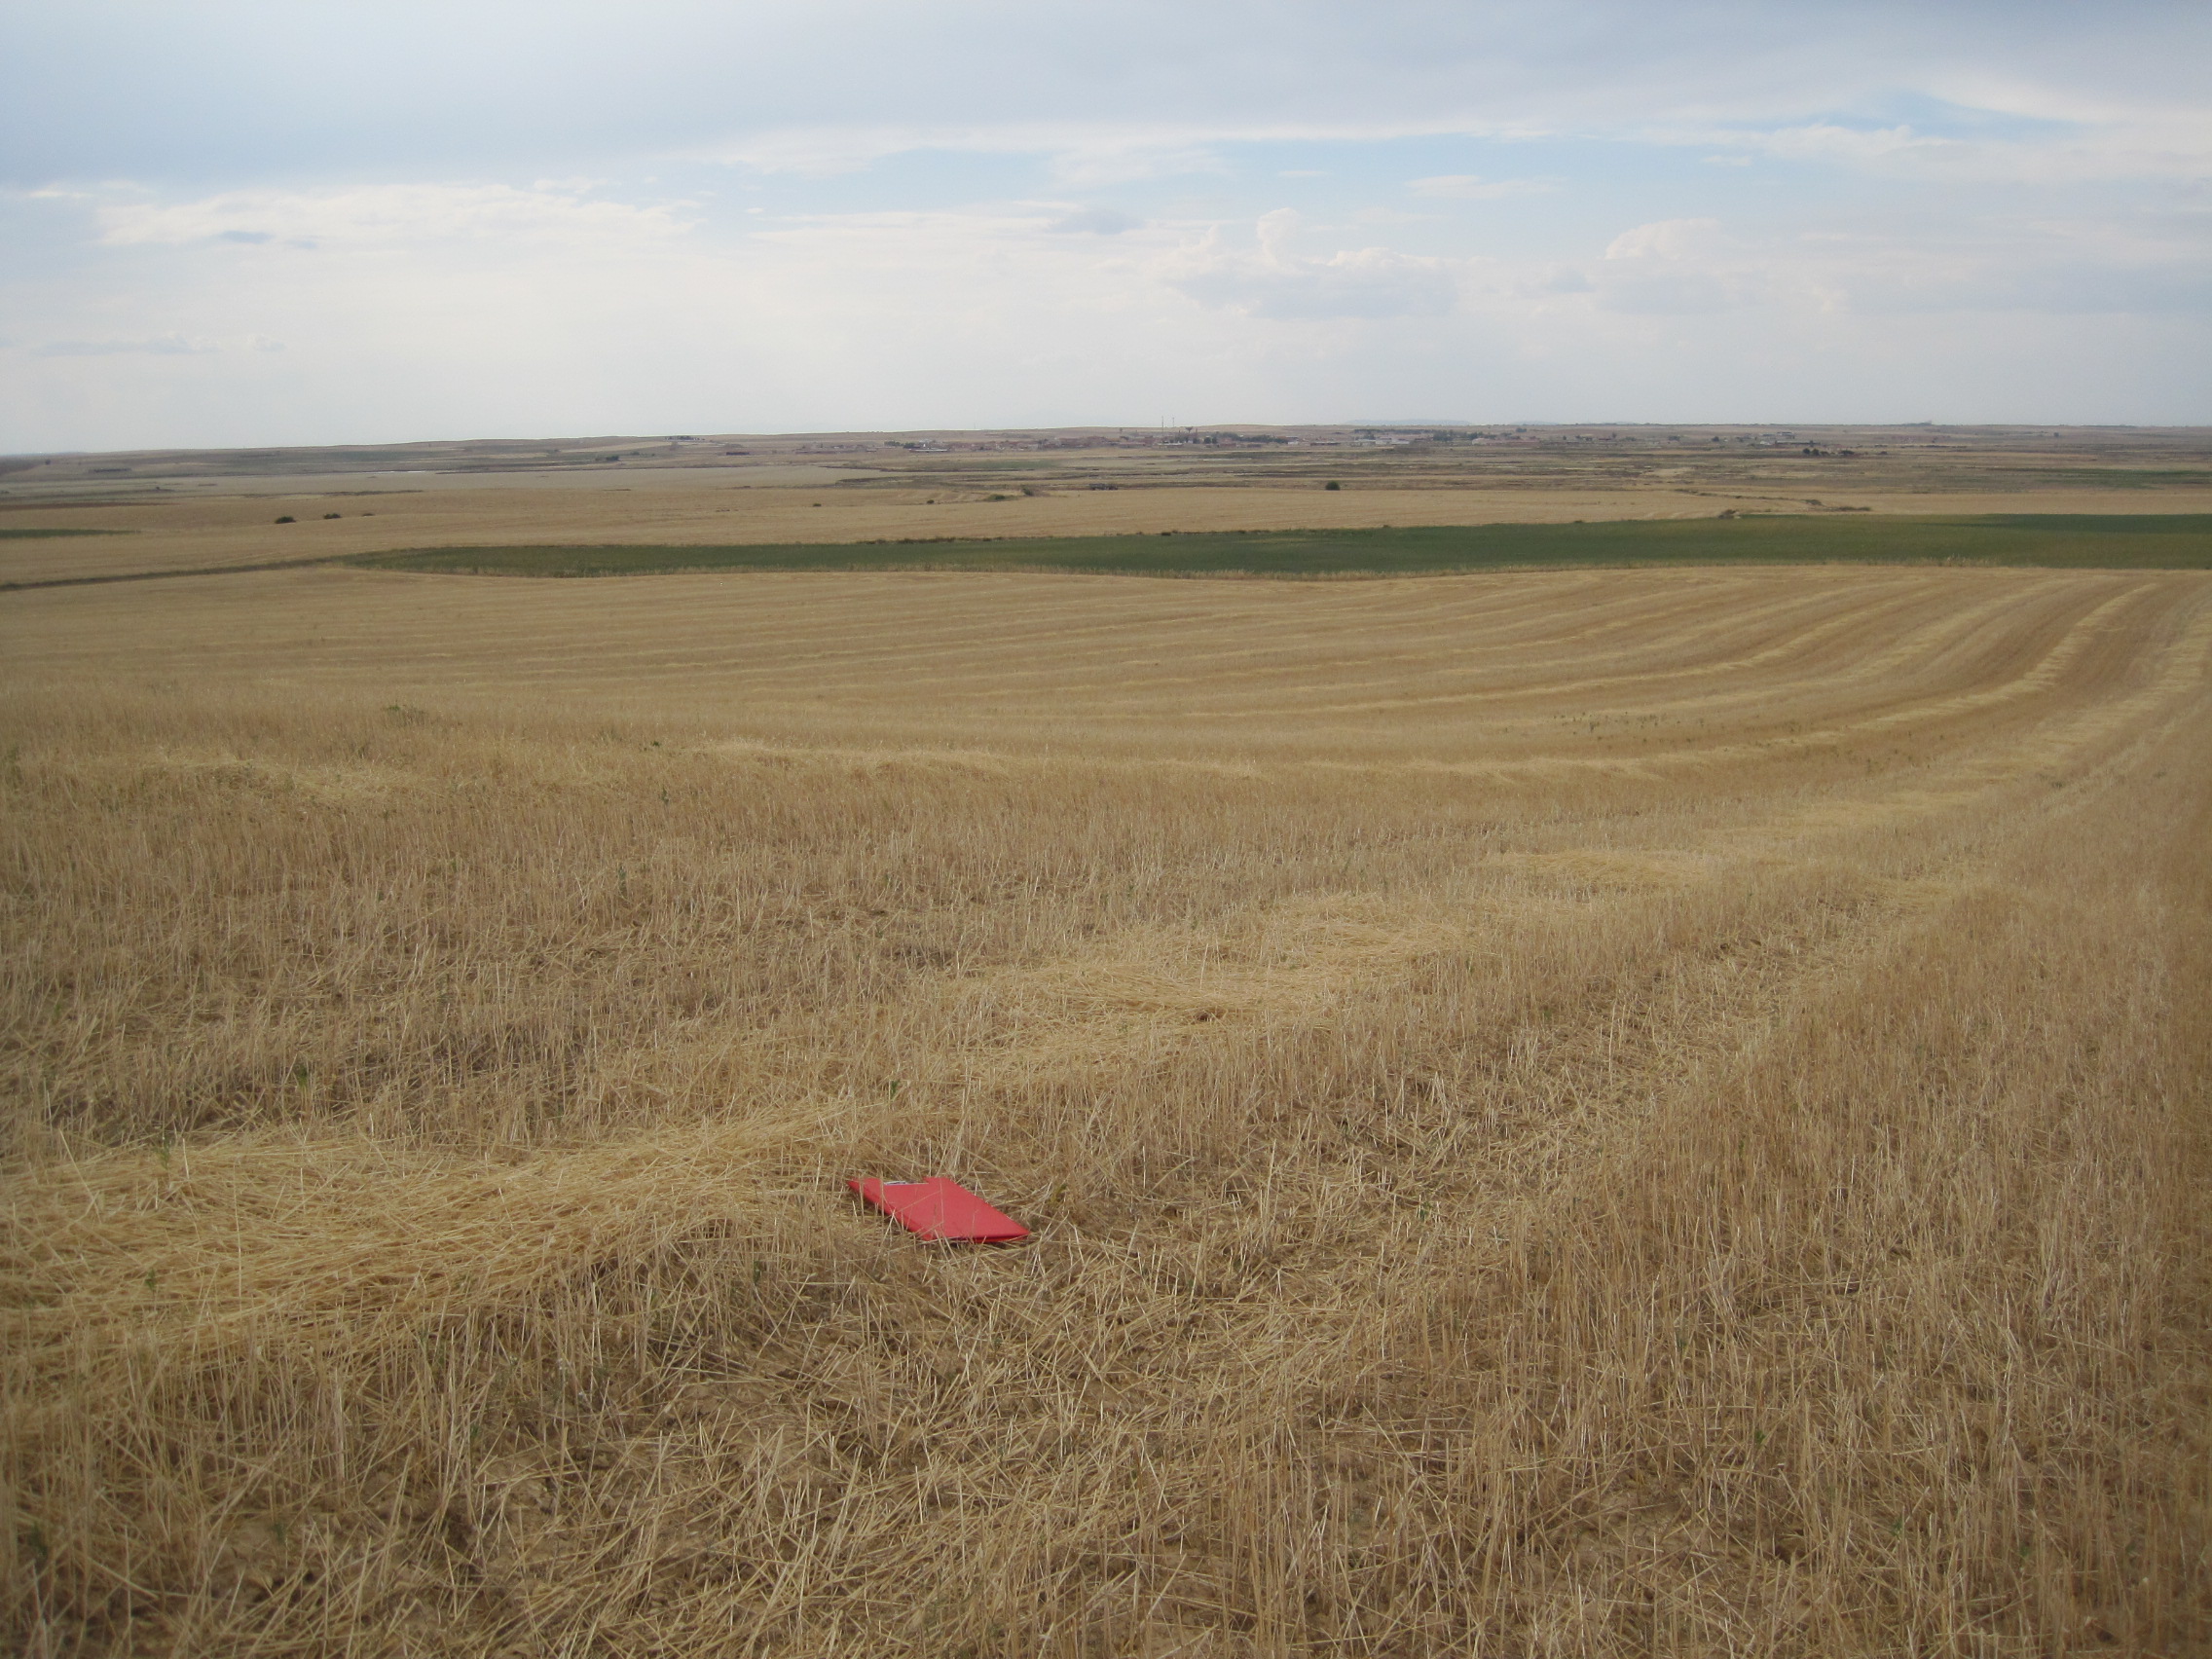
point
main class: Cropland
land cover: Rye
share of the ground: < 10 %
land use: Agriculture (excluding fallow land and kitchen gardens)
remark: Harvested field
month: July
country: ES
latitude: 41.8249
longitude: -5.5828
